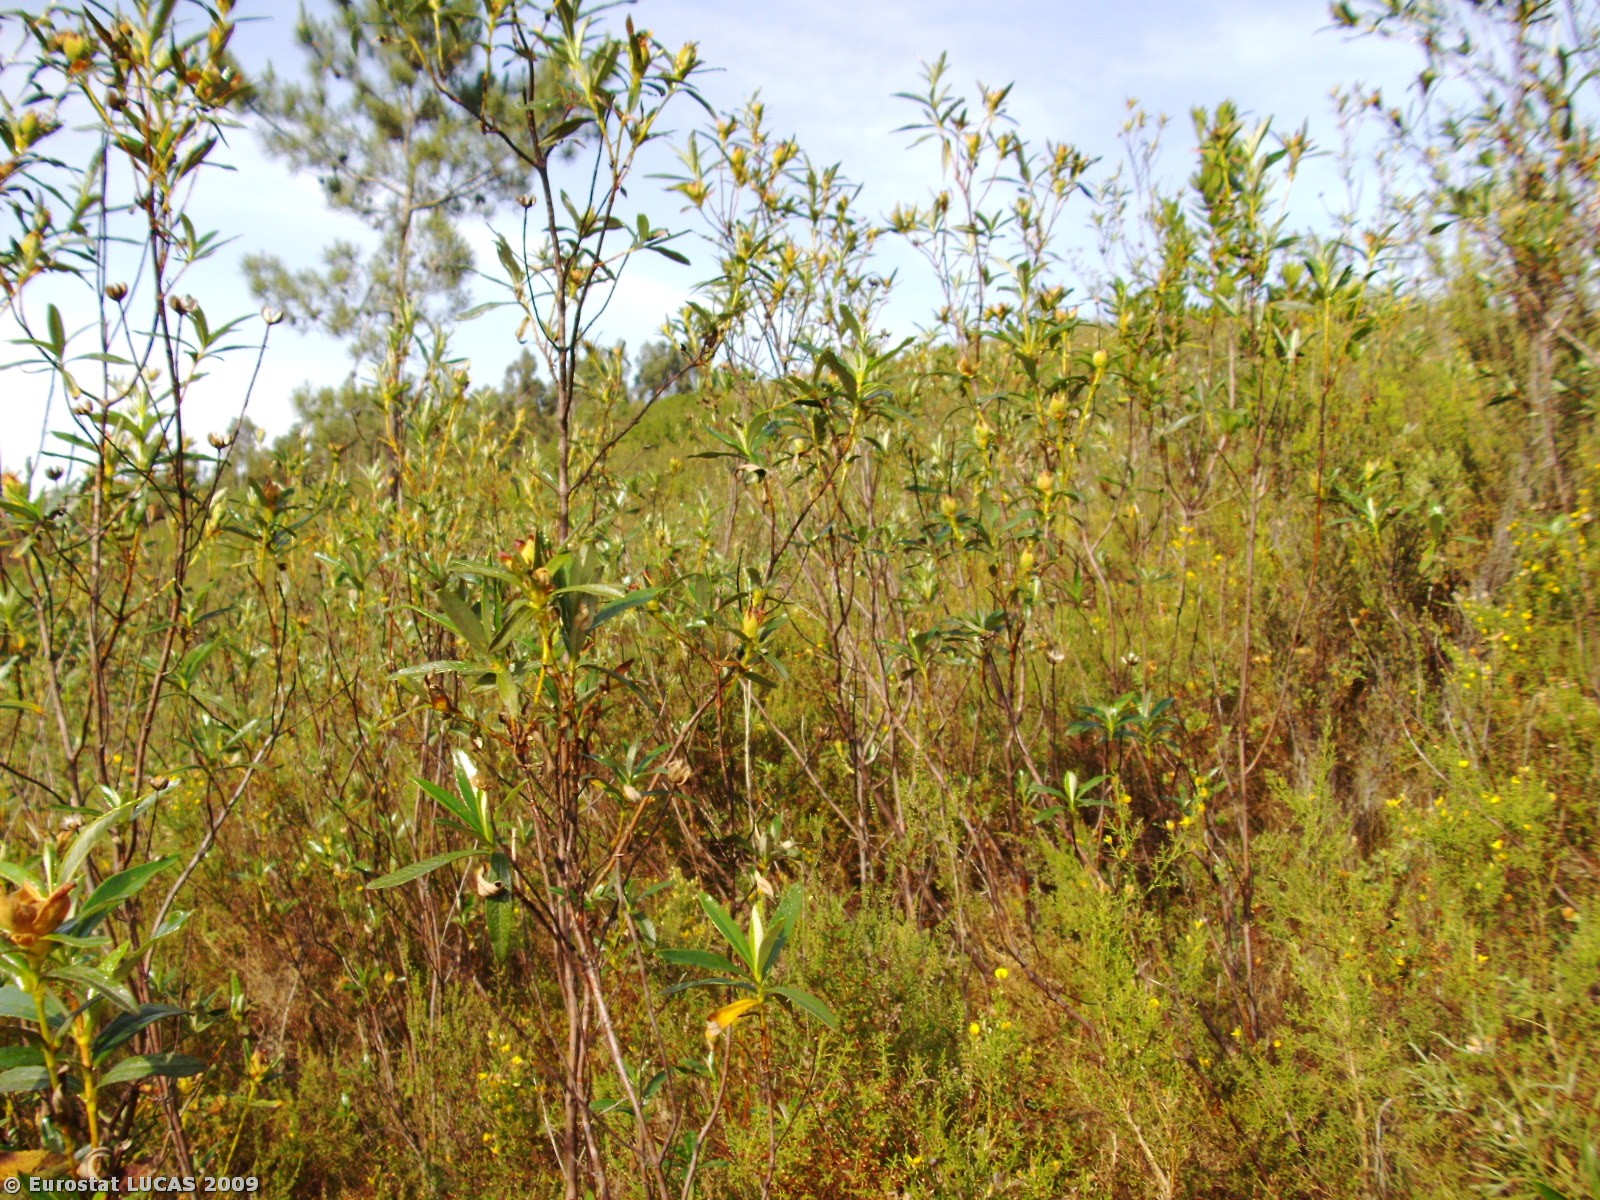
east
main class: Shrubland
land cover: Shrubland without tree cover
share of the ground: > 75 %
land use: Unused
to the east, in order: Shrubland without tree cover; Shrubland with sparse tree cover; Coniferous woodland; Tracks; Coniferous woodland; Shrubland with sparse tree cover
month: June
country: PT
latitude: 37.3850
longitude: -8.7508
